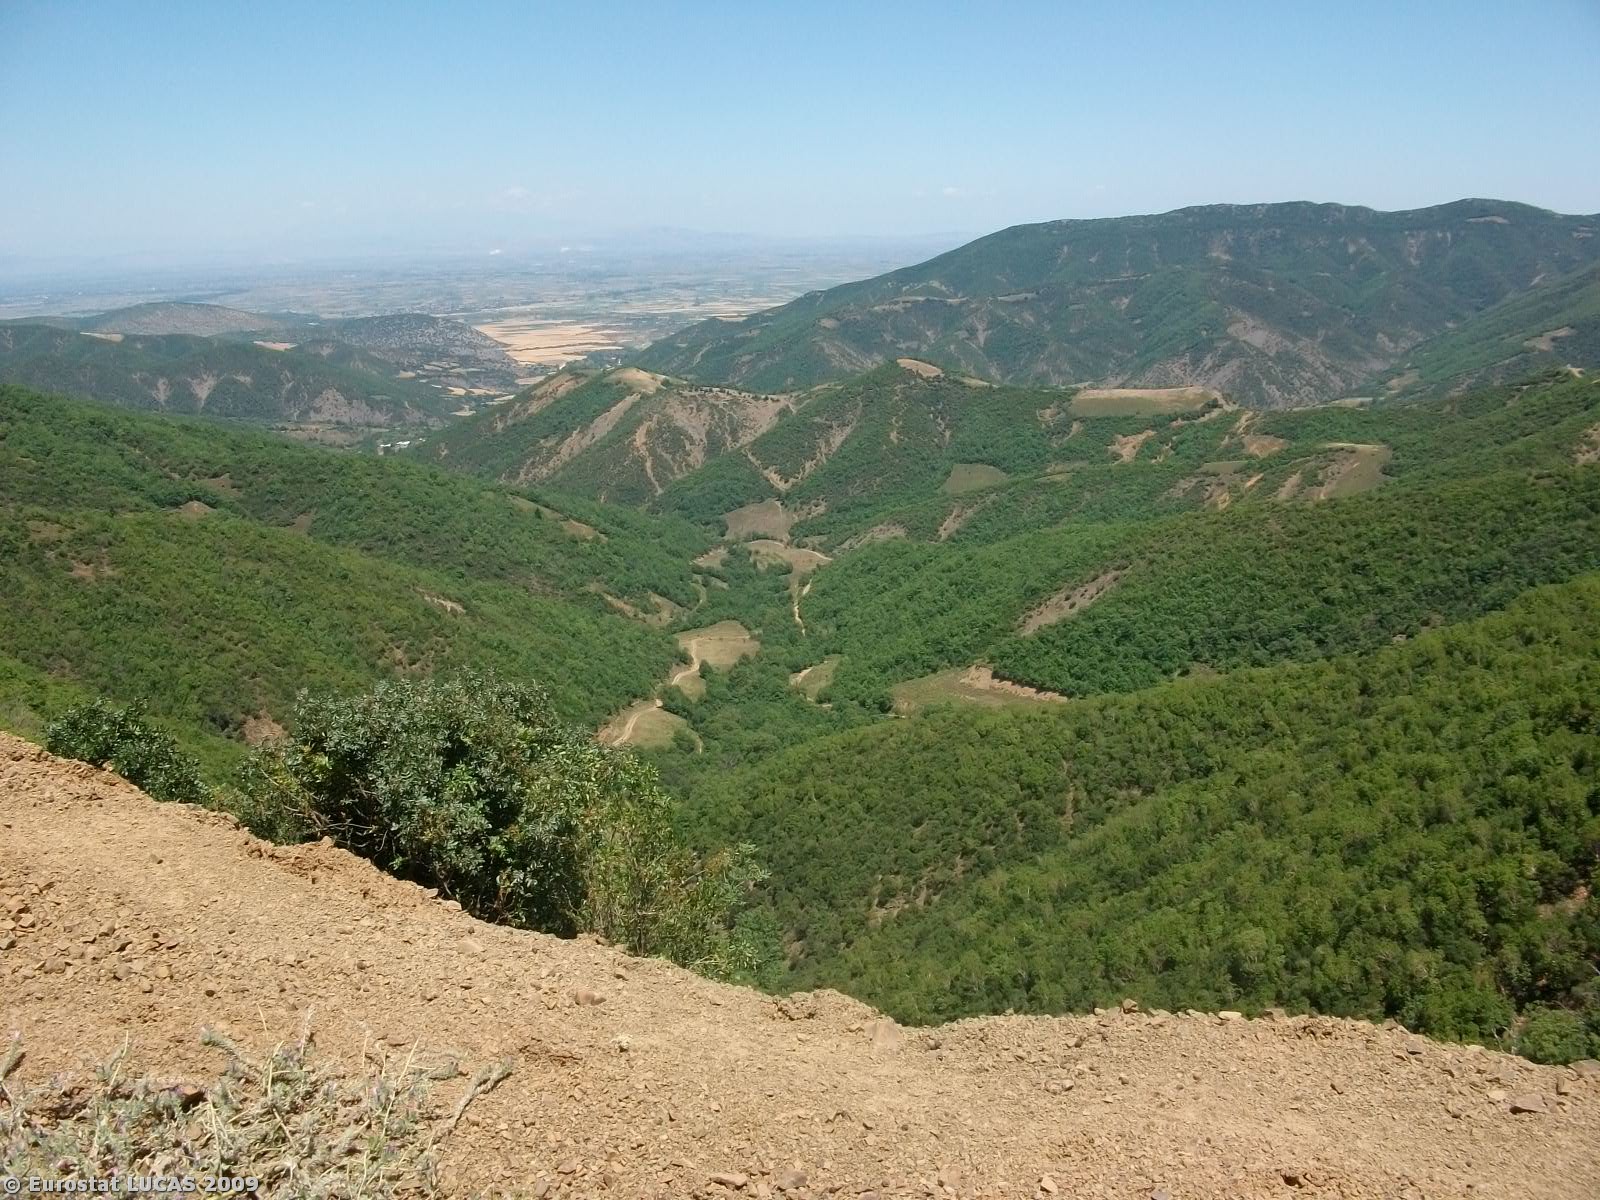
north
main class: Woodland
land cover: Broadleaved woodland
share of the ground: > 75 %
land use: Forestry
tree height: < 5 m
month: July
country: GR
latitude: 39.1910
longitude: 21.9170
